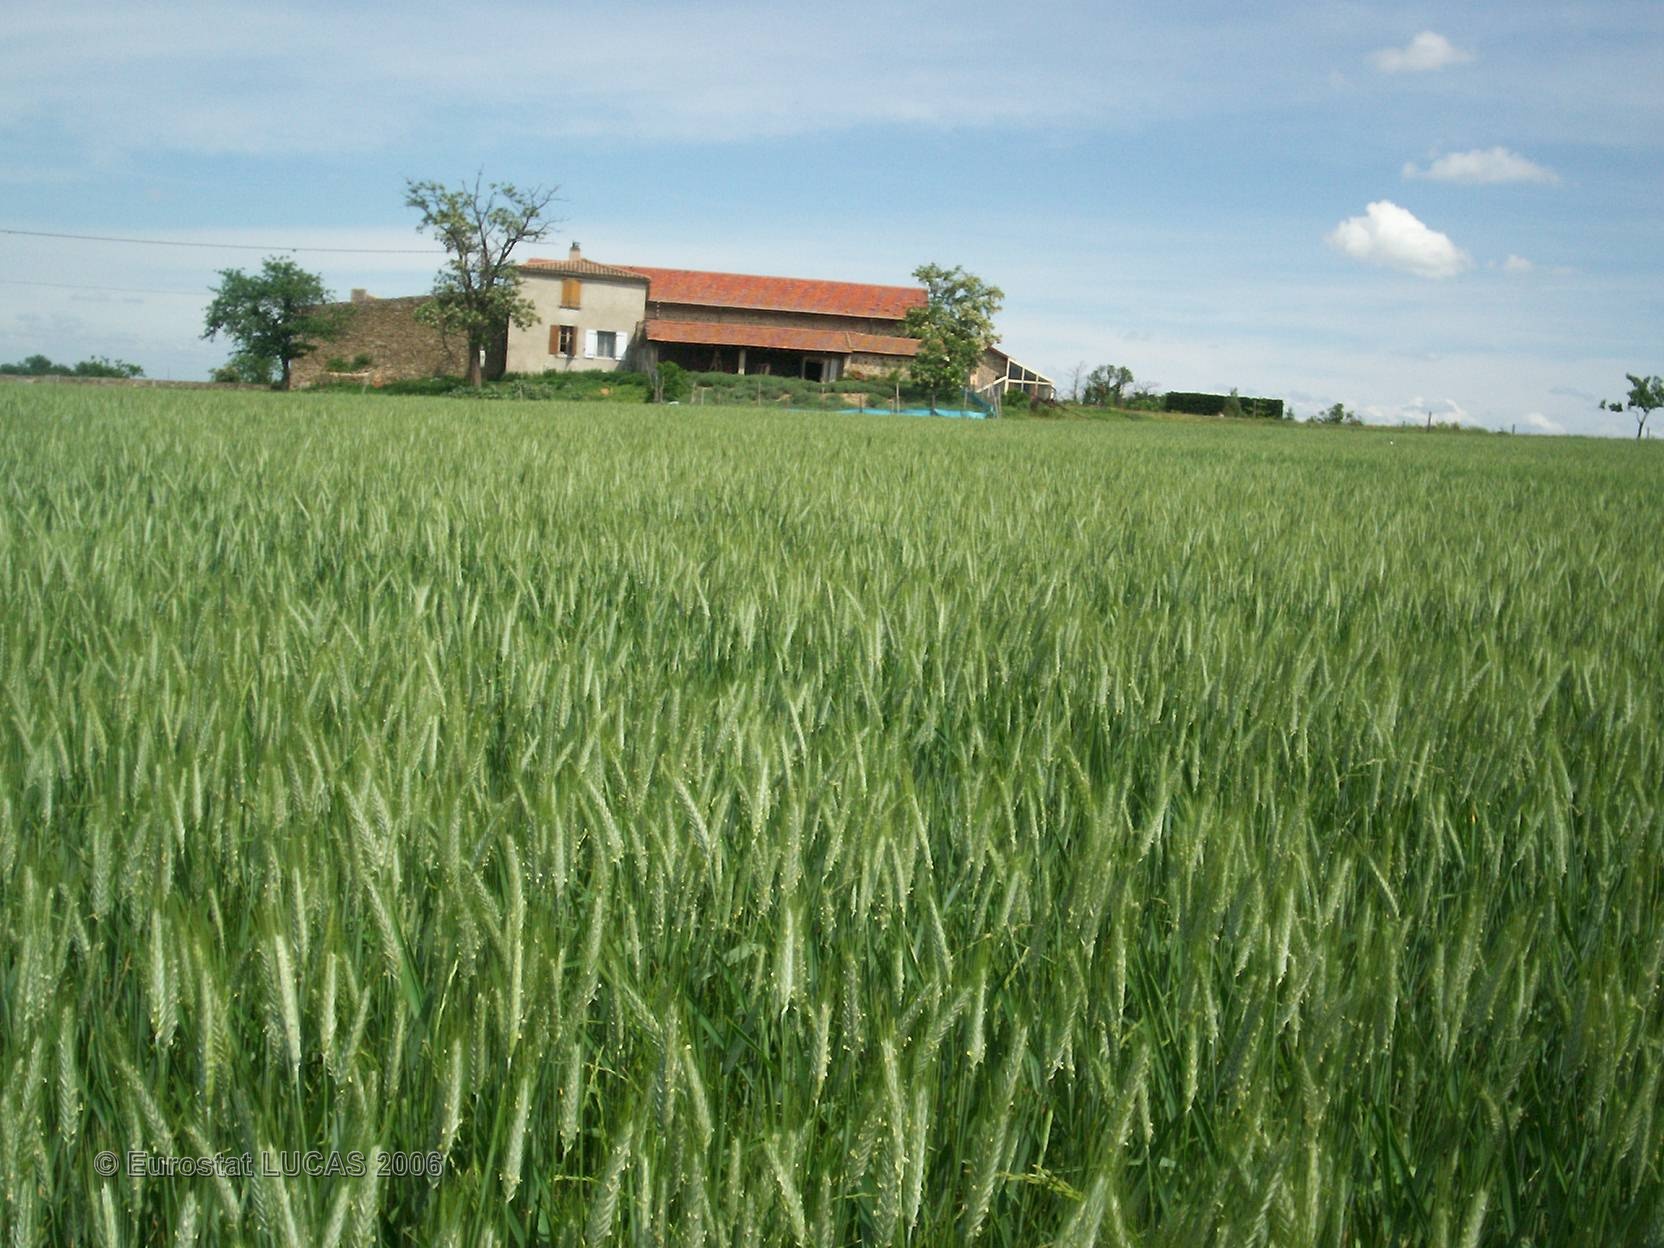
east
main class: Cropland
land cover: Triticale
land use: Agriculture (excluding fallow land and kitchen gardens)
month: May
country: FR
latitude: 45.2303
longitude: 4.7699
